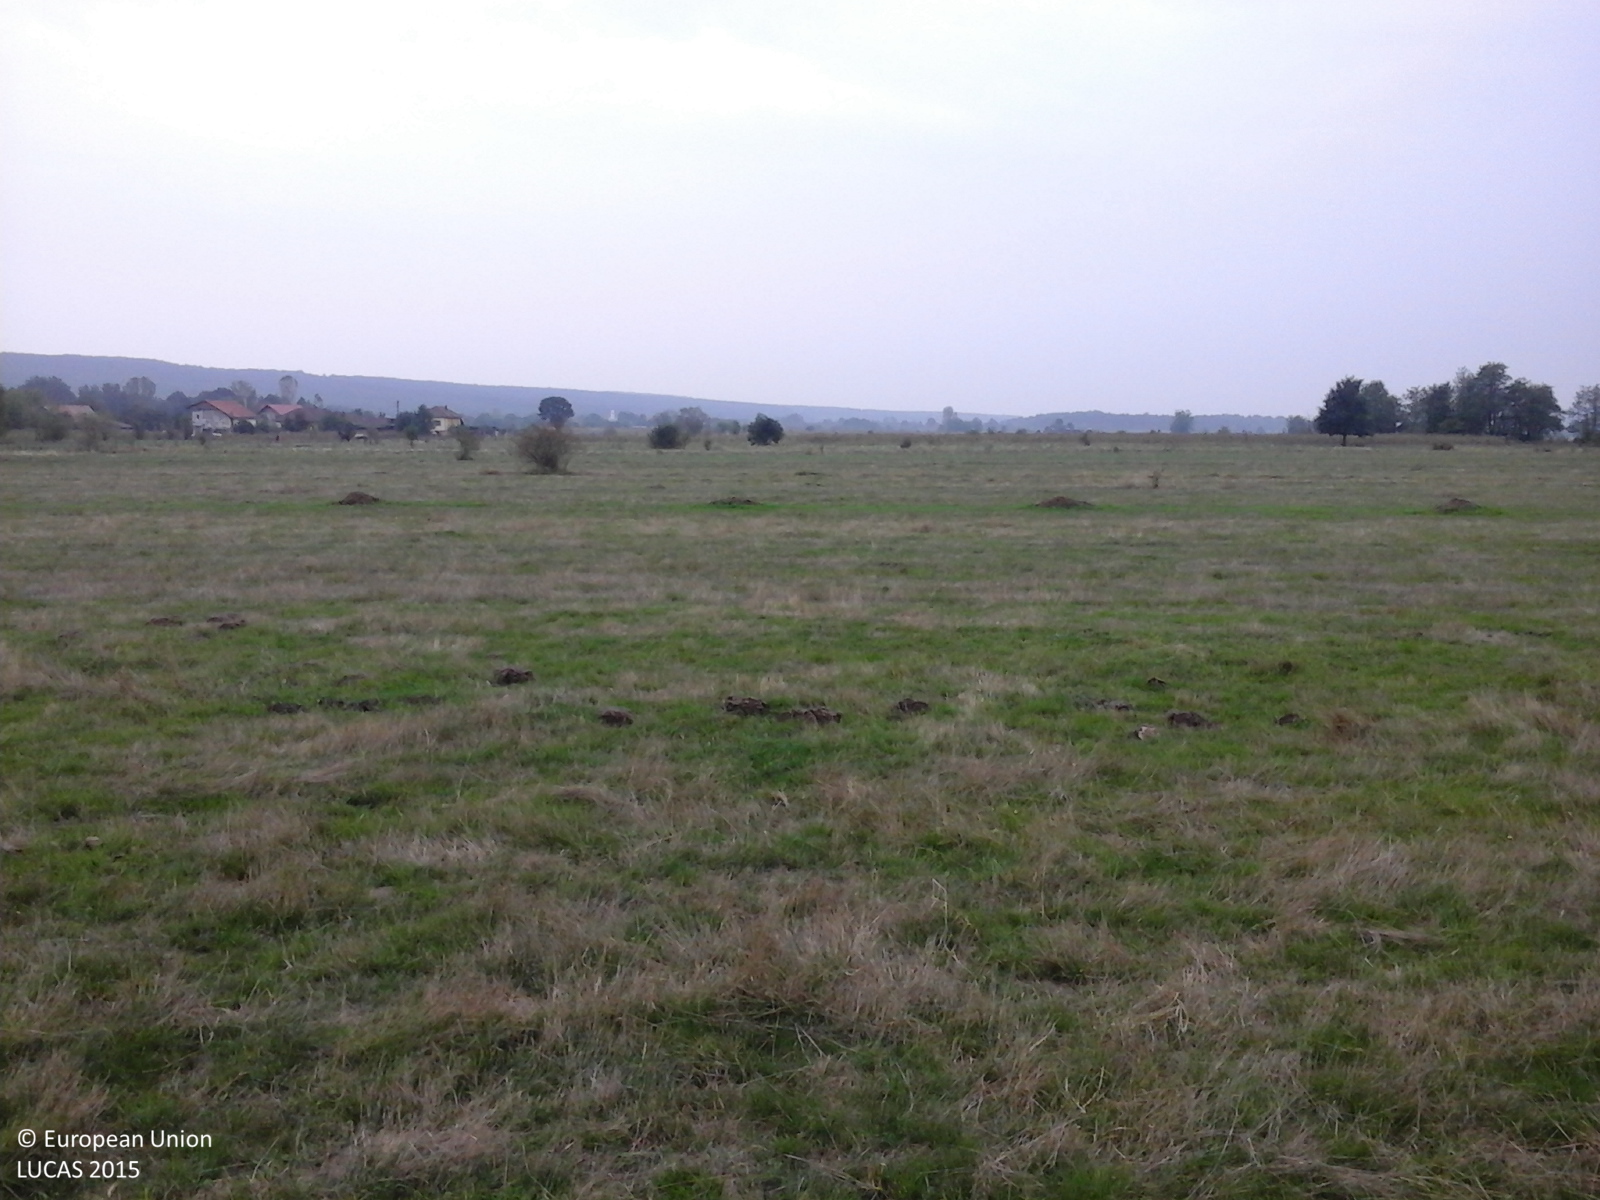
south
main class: Grassland
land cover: Grassland without tree/shrub cover
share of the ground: > 75 %
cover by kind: herbaceous plants 100 %
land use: Agriculture (excluding fallow land and kitchen gardens)
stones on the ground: < 10 %
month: September
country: RO
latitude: 45.1019
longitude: 23.2581
